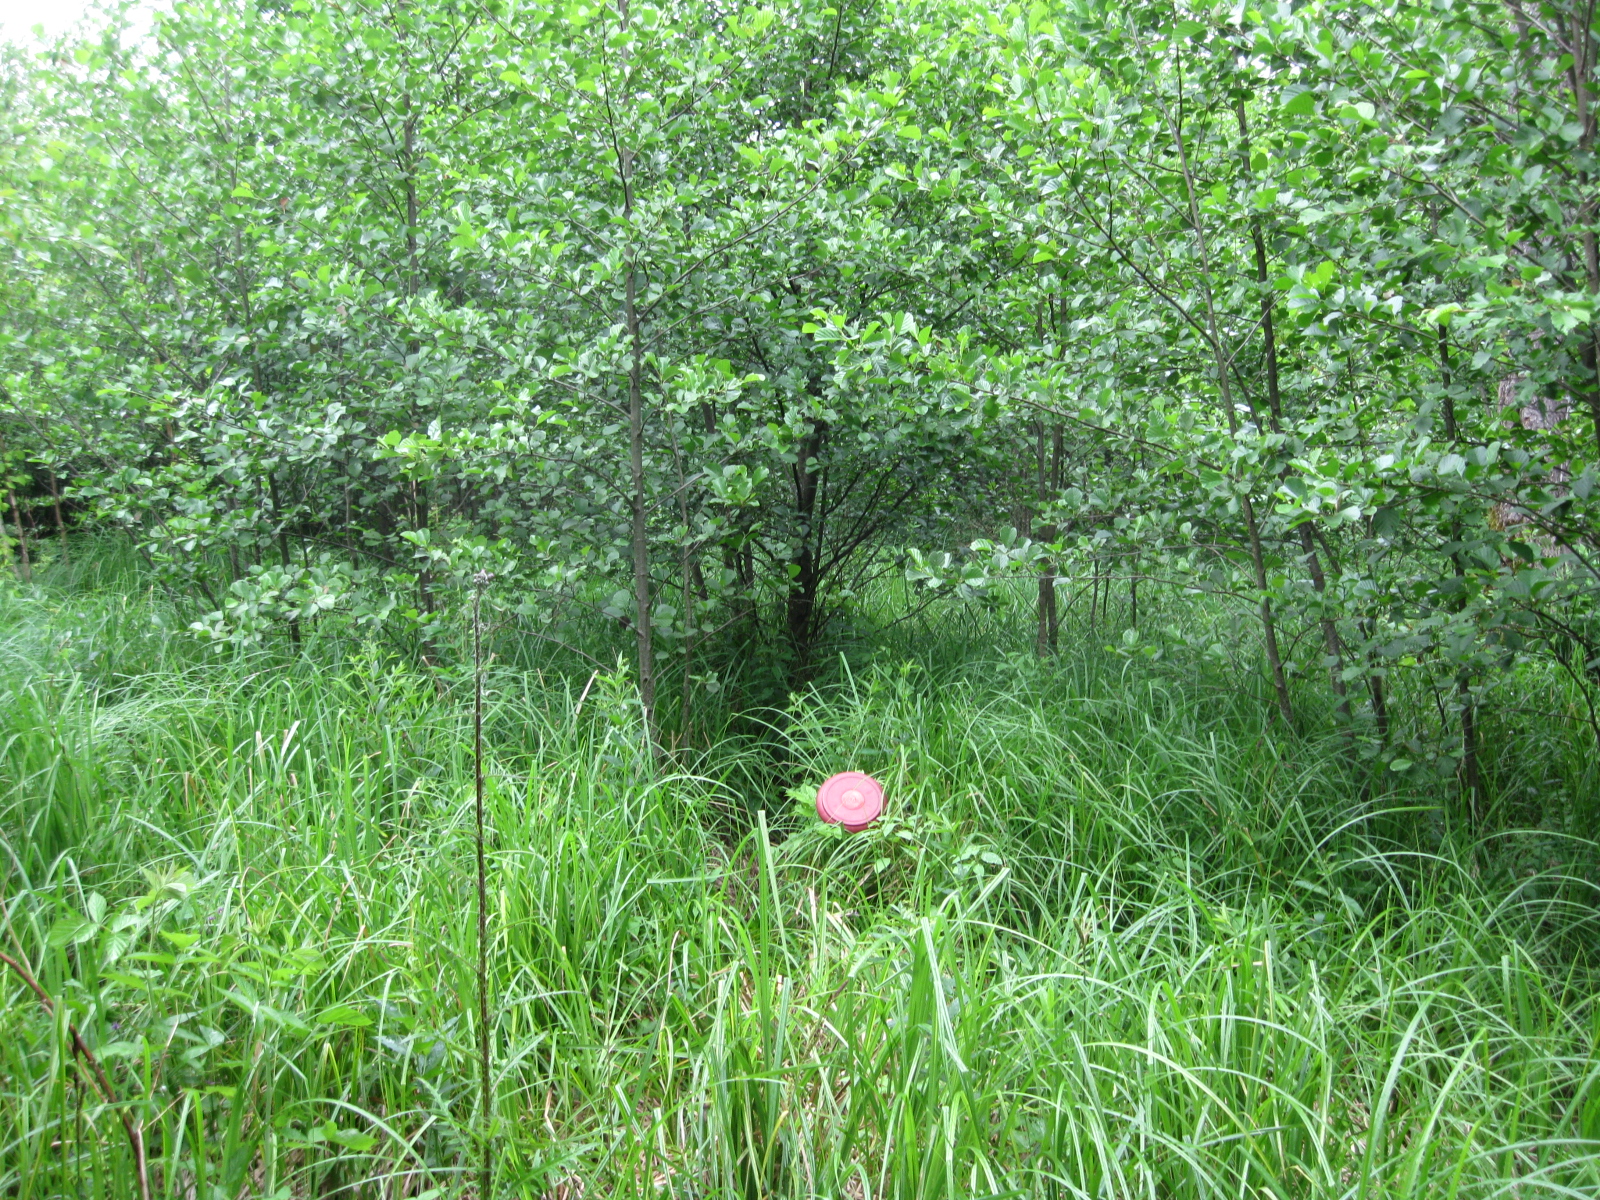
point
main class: Woodland
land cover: Broadleaved woodland
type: non-riverine alder, birch or aspen forest
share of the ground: > 75 %
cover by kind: broadleaved forest trees 80 %, herbaceous plants 15 %, shrubs 5 %
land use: Forestry
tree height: < 5 m
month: June
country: LT
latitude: 55.1016
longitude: 24.0240
